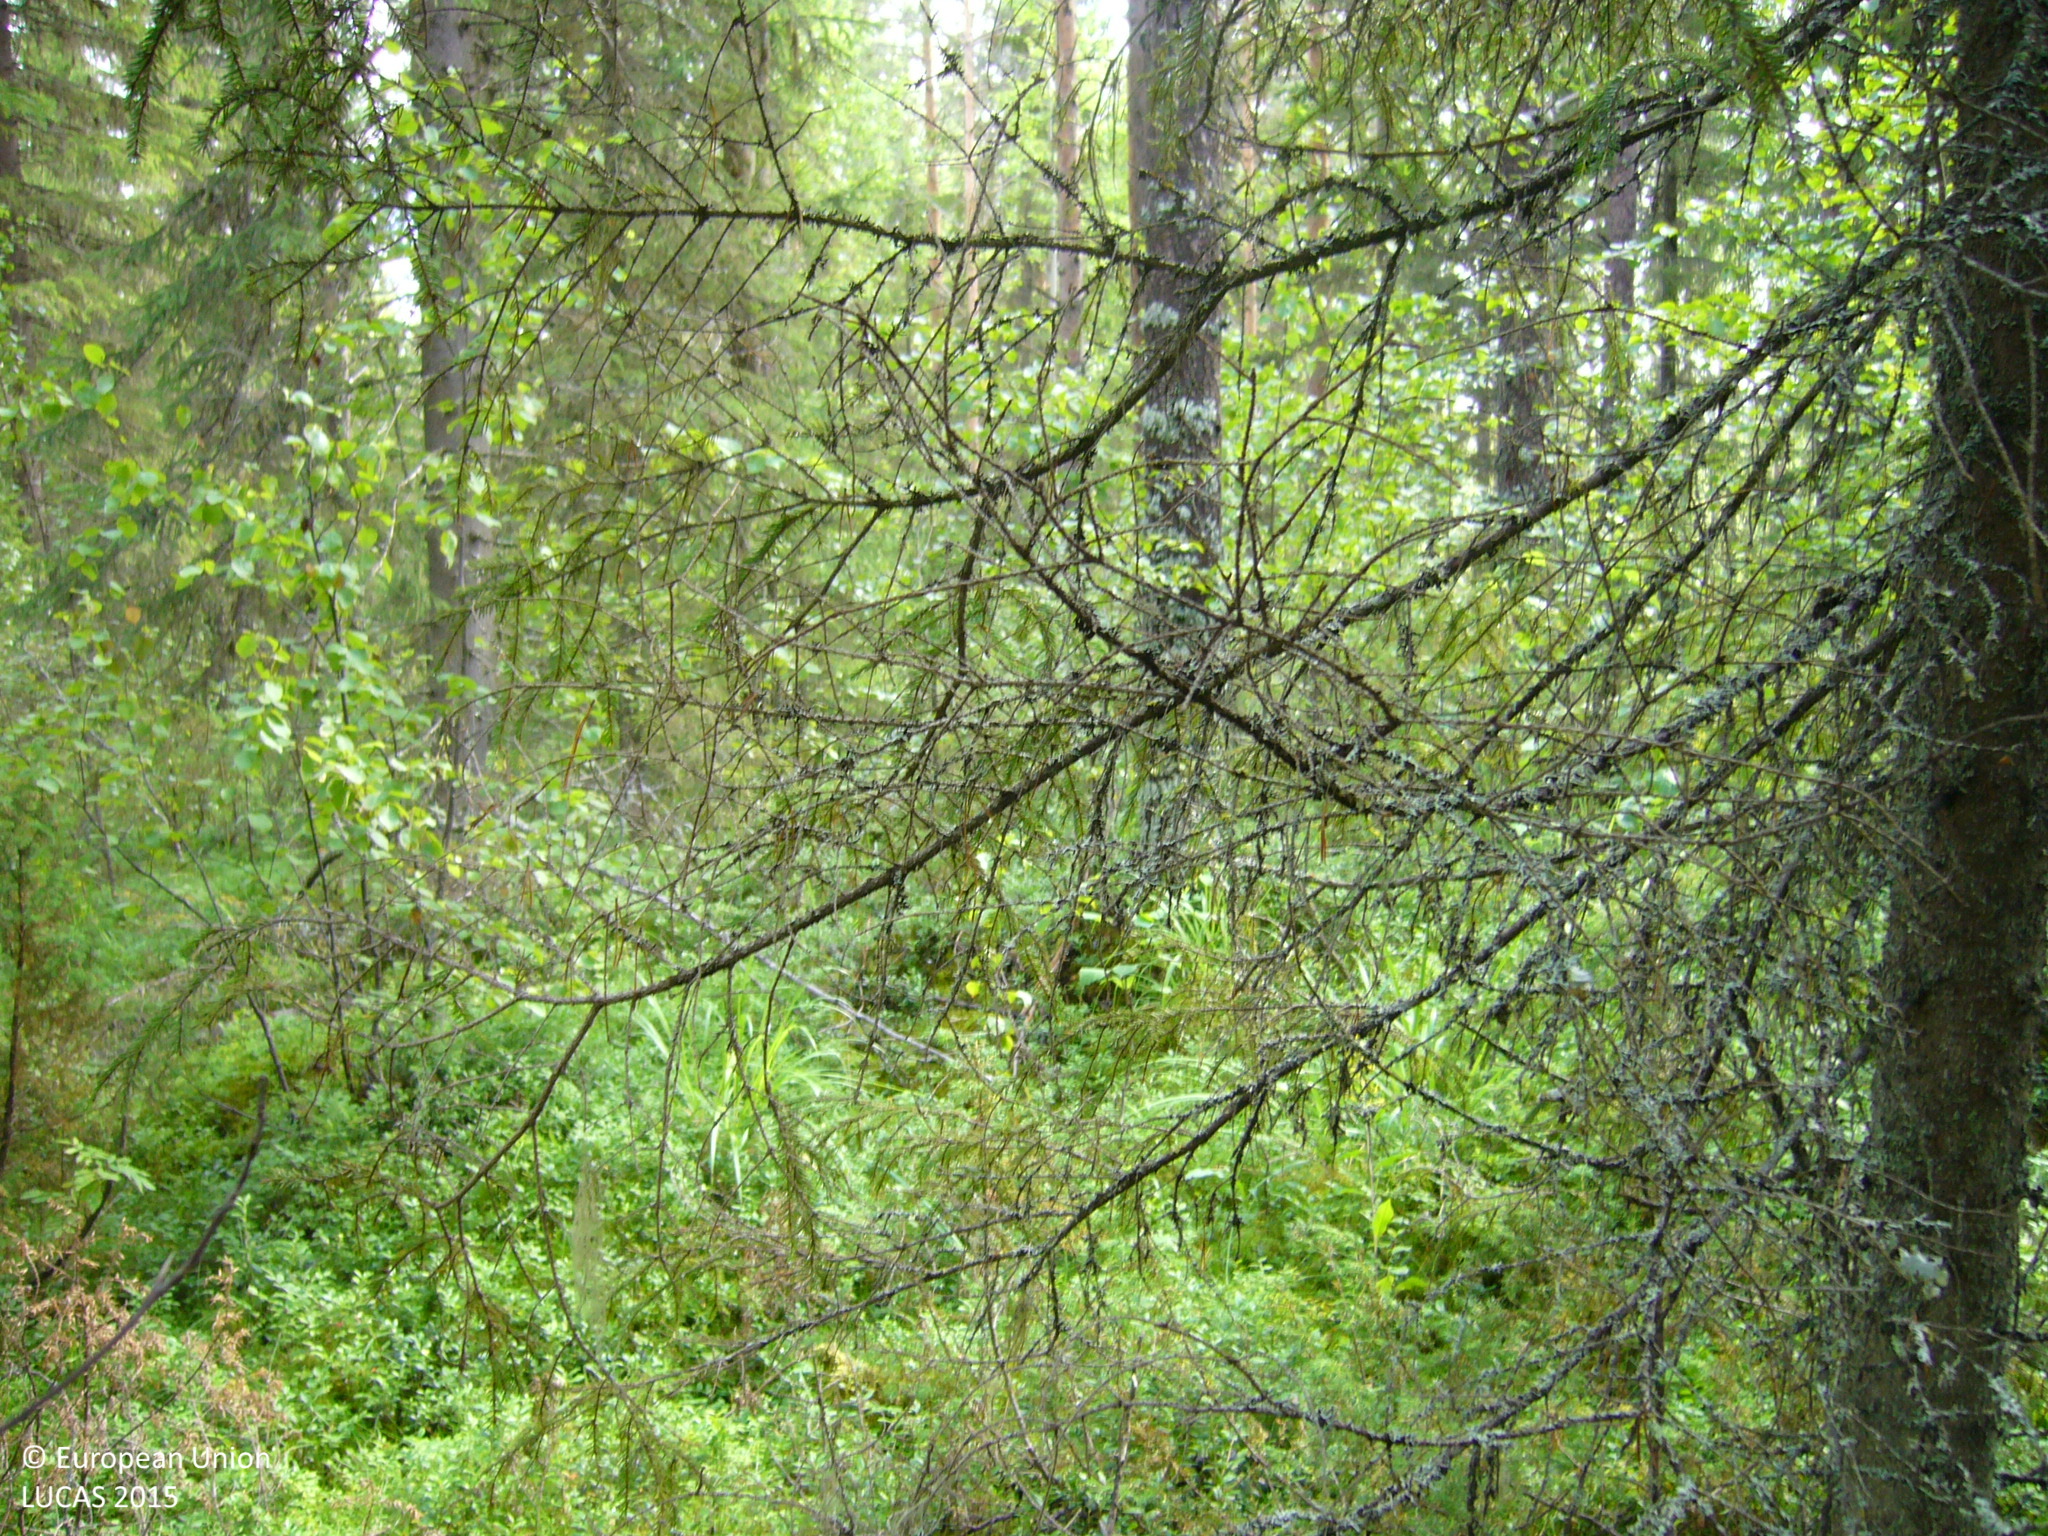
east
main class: Woodland
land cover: Spruce dominated coniferous woodland
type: boreal forest
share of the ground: > 75 %
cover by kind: coniferous forest trees 60 %, shrubs 25 %, broadleaved forest trees 15 %
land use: Forestry
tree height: > 5 m
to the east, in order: Spruce dominated coniferous woodland; Tracks; Spruce dominated coniferous woodland; Spruce dominated mixed woodland; Ditches and canals; Spruce dominated mixed woodland; Tracks; Spruce dominated mixed woodland; Other mixed woodland
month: July
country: FI
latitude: 63.9070
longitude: 26.5689
